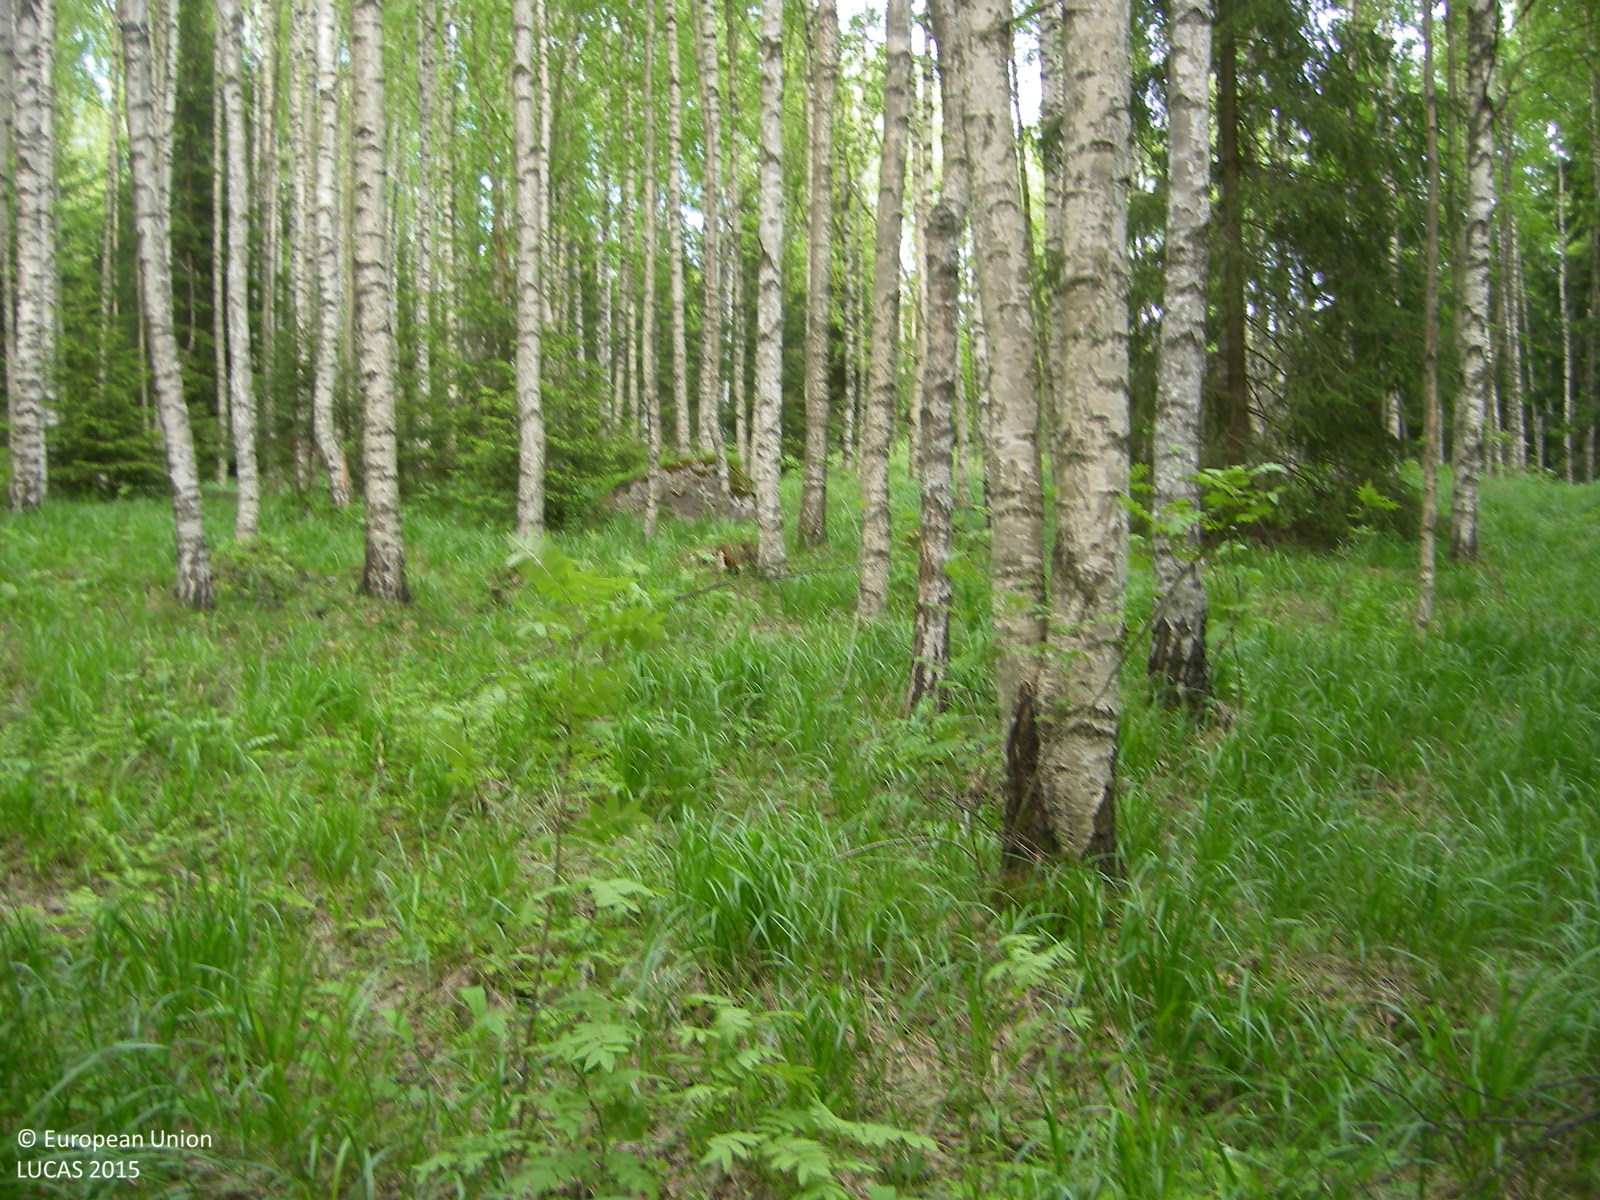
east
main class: Woodland
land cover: Broadleaved woodland
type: boreal forest
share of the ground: > 75 %
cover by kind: broadleaved forest trees 80 %, herbaceous plants 15 %, coniferous forest trees 5 %
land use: Forestry
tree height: > 5 m
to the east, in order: Broadleaved woodland; Spruce dominated coniferous woodland; Spruce dominated mixed woodland
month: June
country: FI
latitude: 60.3088
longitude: 24.8295
